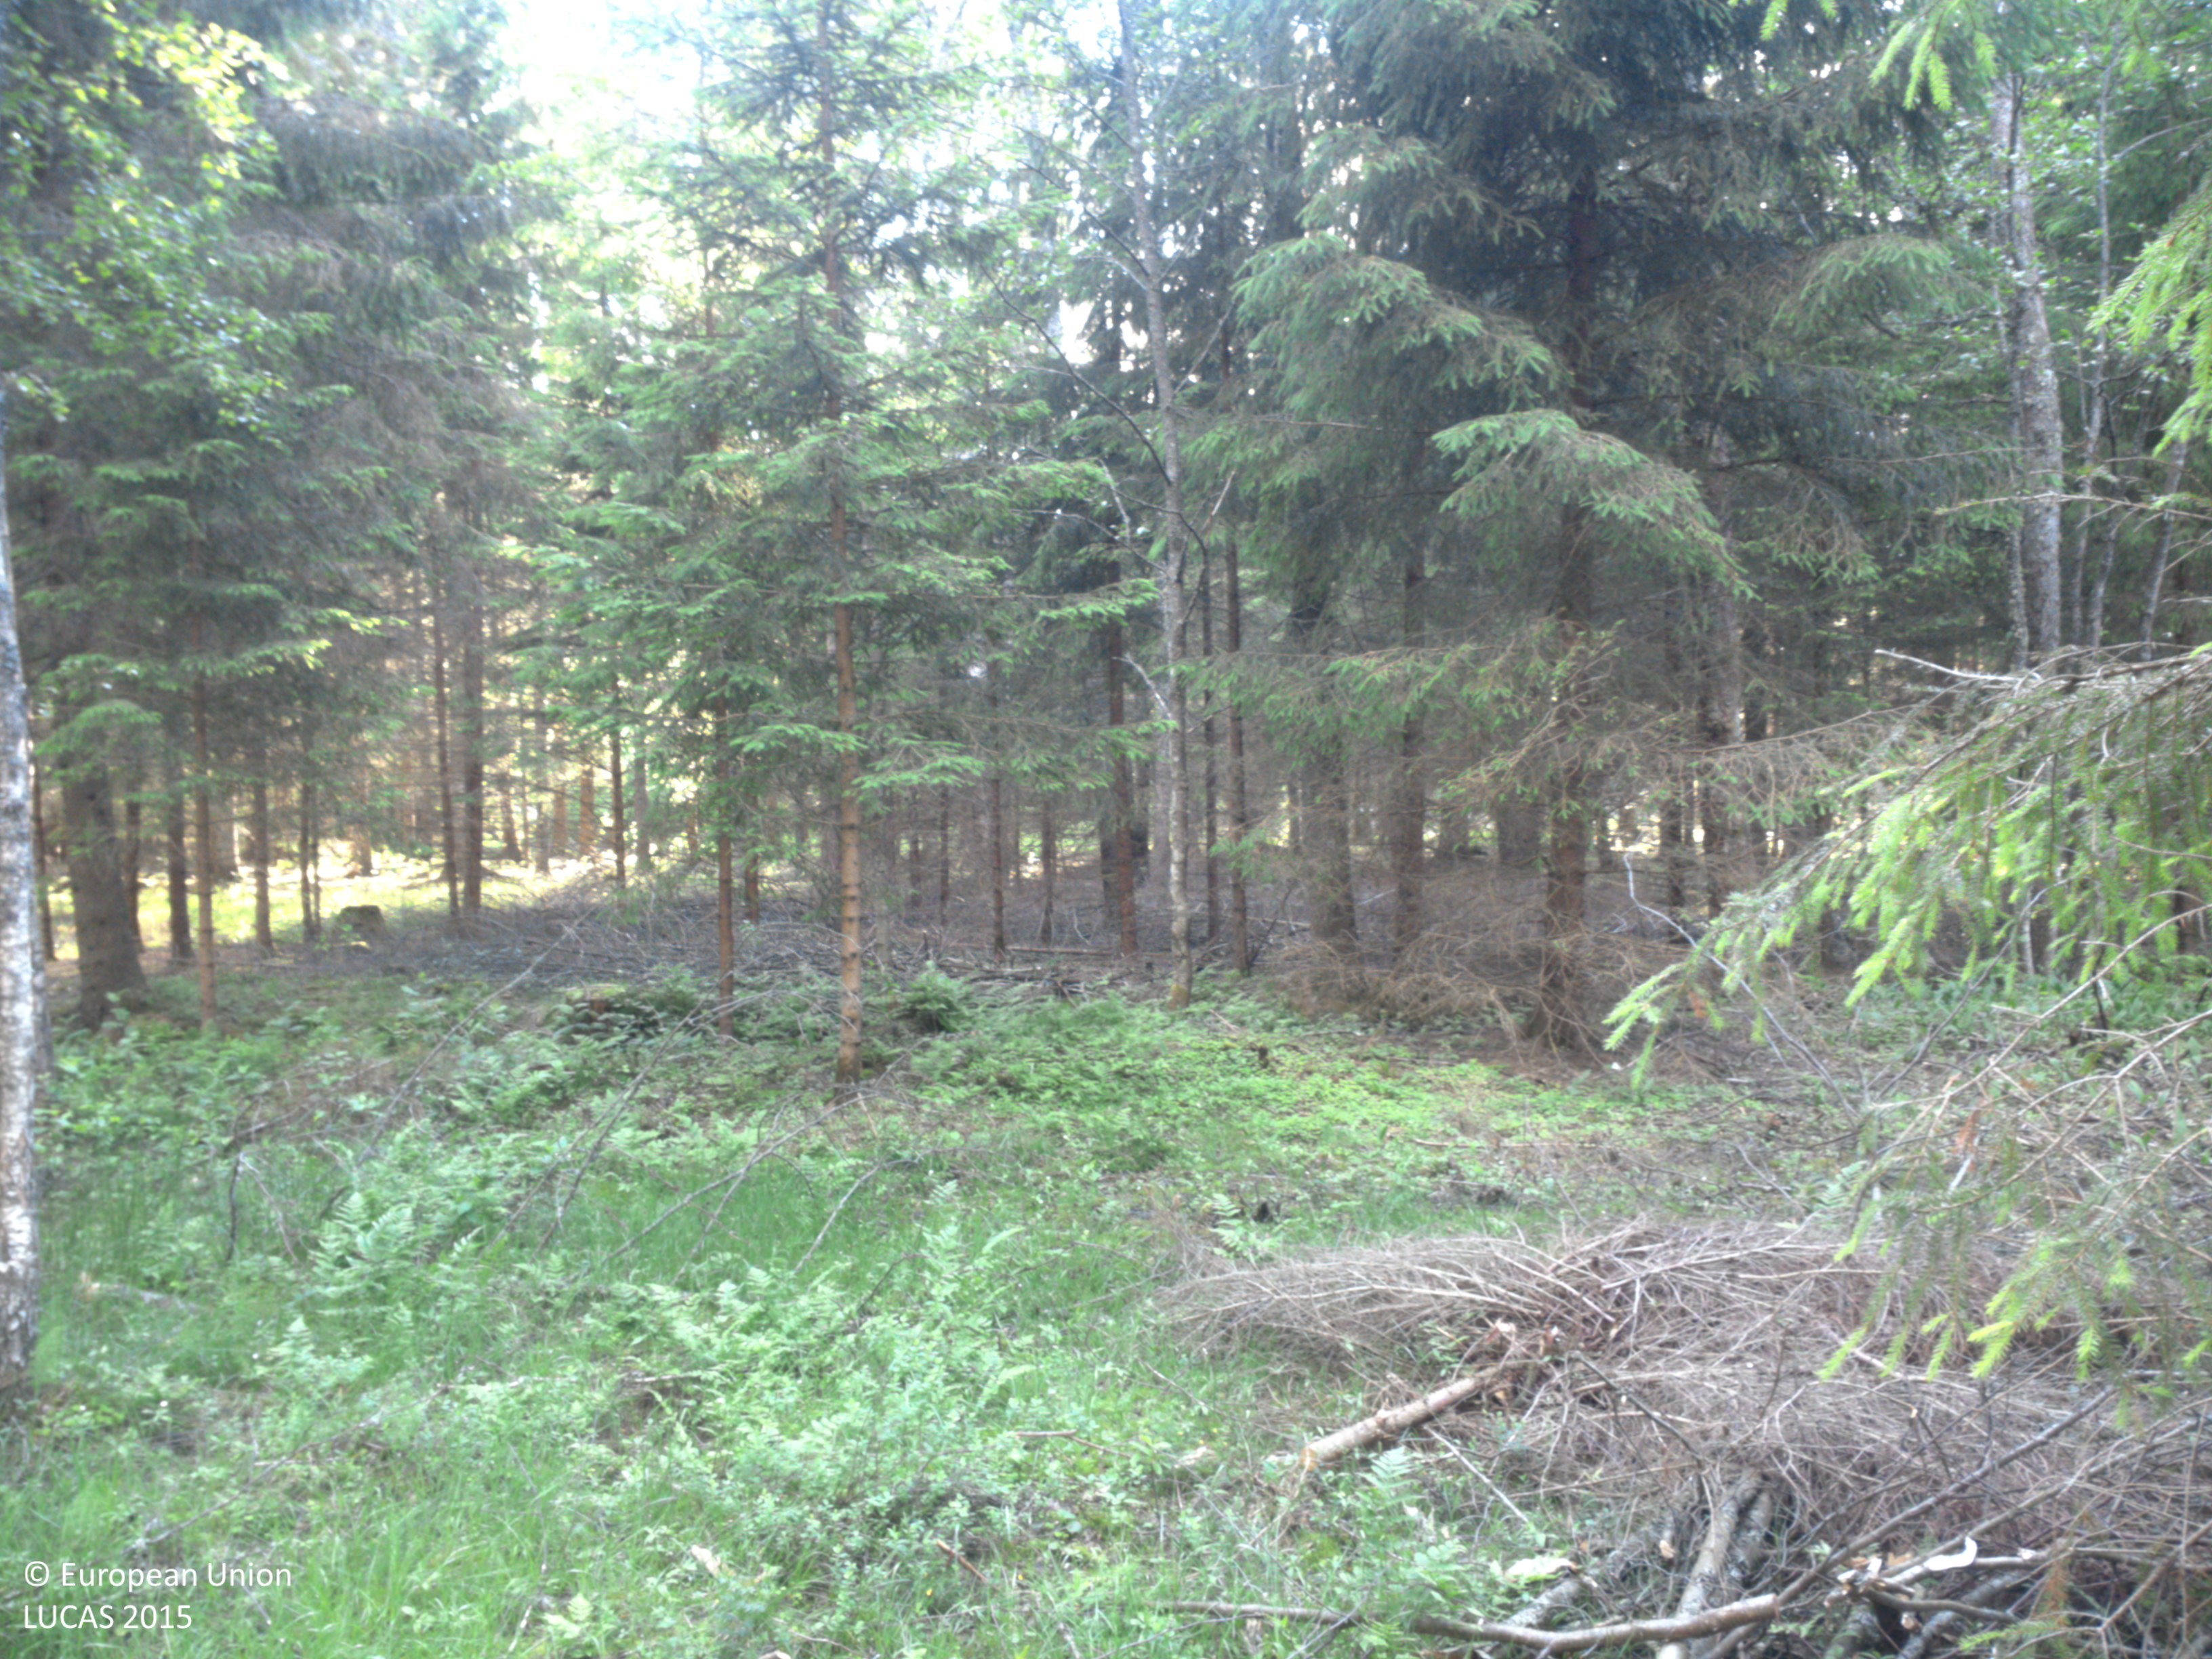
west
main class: Woodland
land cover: Spruce dominated mixed woodland
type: boreal forest
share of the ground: 50 - 75 %
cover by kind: coniferous forest trees 40 %, herbaceous plants 30 %, broadleaved forest trees 25 %, shrubs 5 %
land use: Forestry
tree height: > 5 m
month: June
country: SE
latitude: 58.8583
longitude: 11.5393
